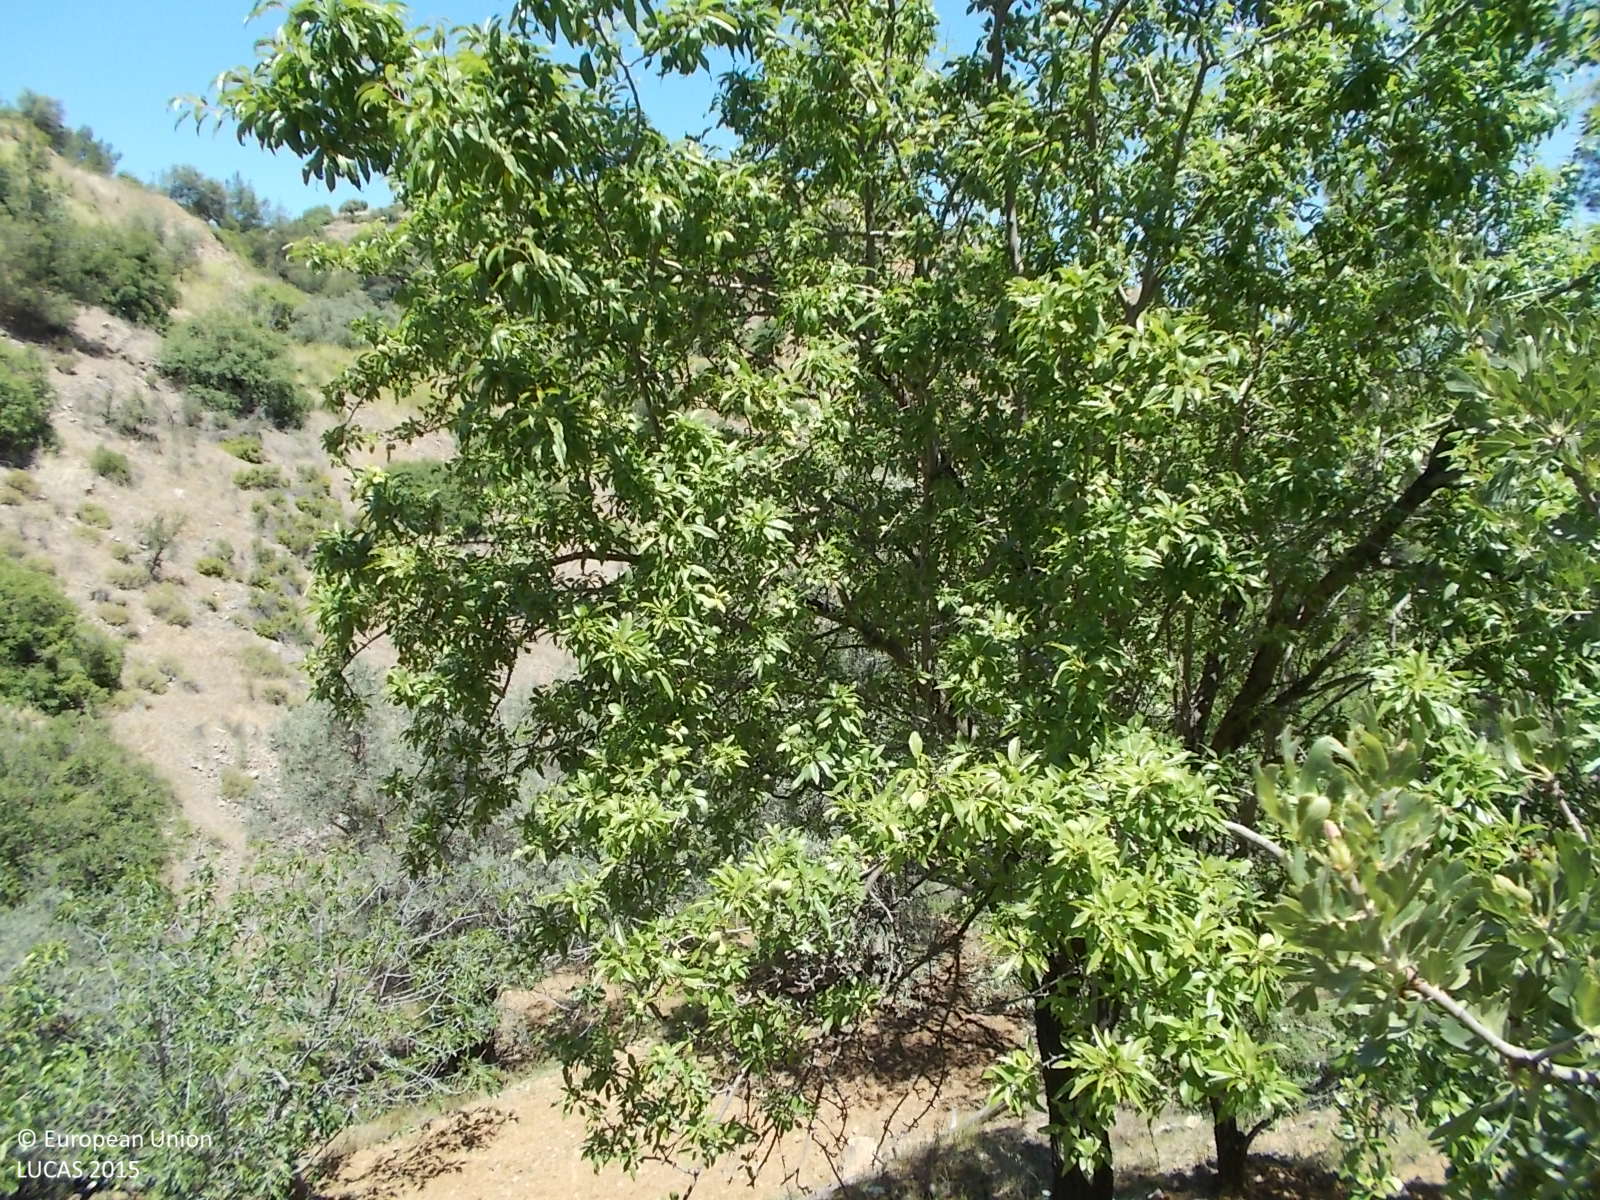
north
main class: Shrubland
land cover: Shrubland with sparse tree cover
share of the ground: > 75 %
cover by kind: shrubs 90 %, broadleaved forest trees 5 %, unconsolidated bare surface 5 %
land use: Semi-natural and natural areas not in use
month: May
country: CY
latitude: 34.9633
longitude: 33.1444
